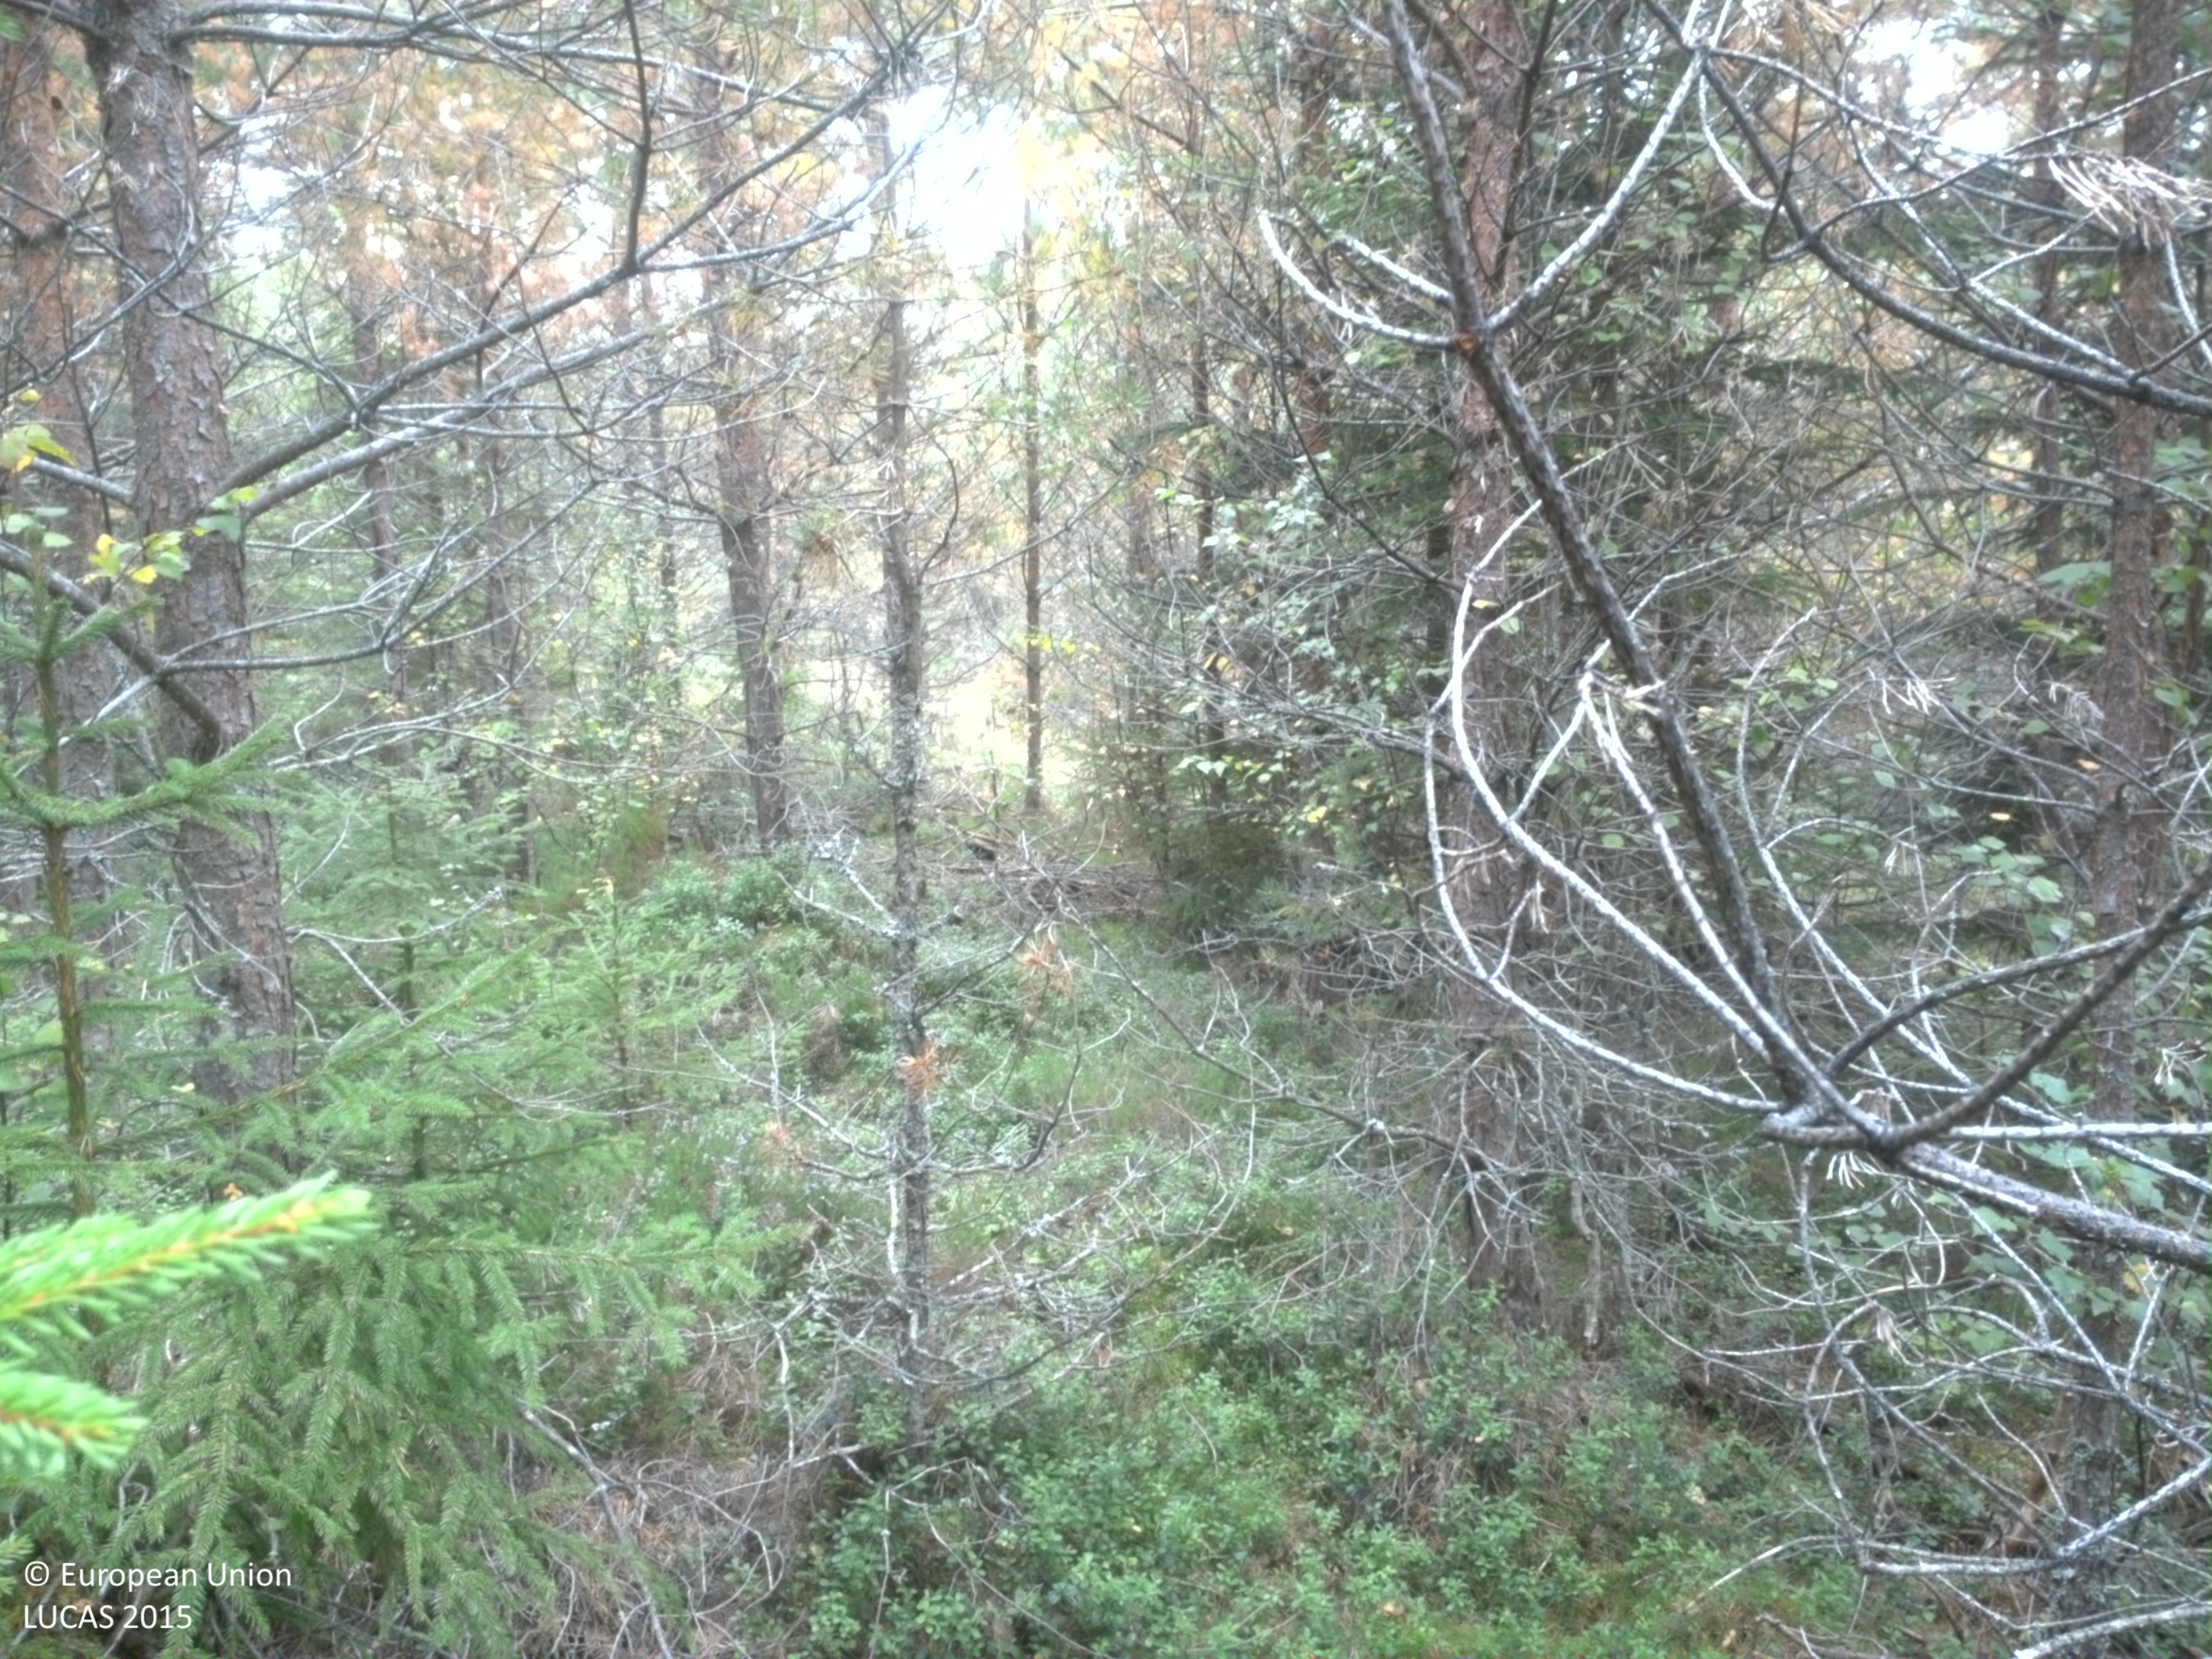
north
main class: Woodland
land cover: Pine dominated coniferous woodland
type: boreal forest
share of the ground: > 75 %
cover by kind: coniferous forest trees 80 %, shrubs 10 %, lichens and mosses 10 %
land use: Forestry
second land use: Amenities, museums, leisure
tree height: > 5 m
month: September
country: SE
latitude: 59.7269
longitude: 15.5923
